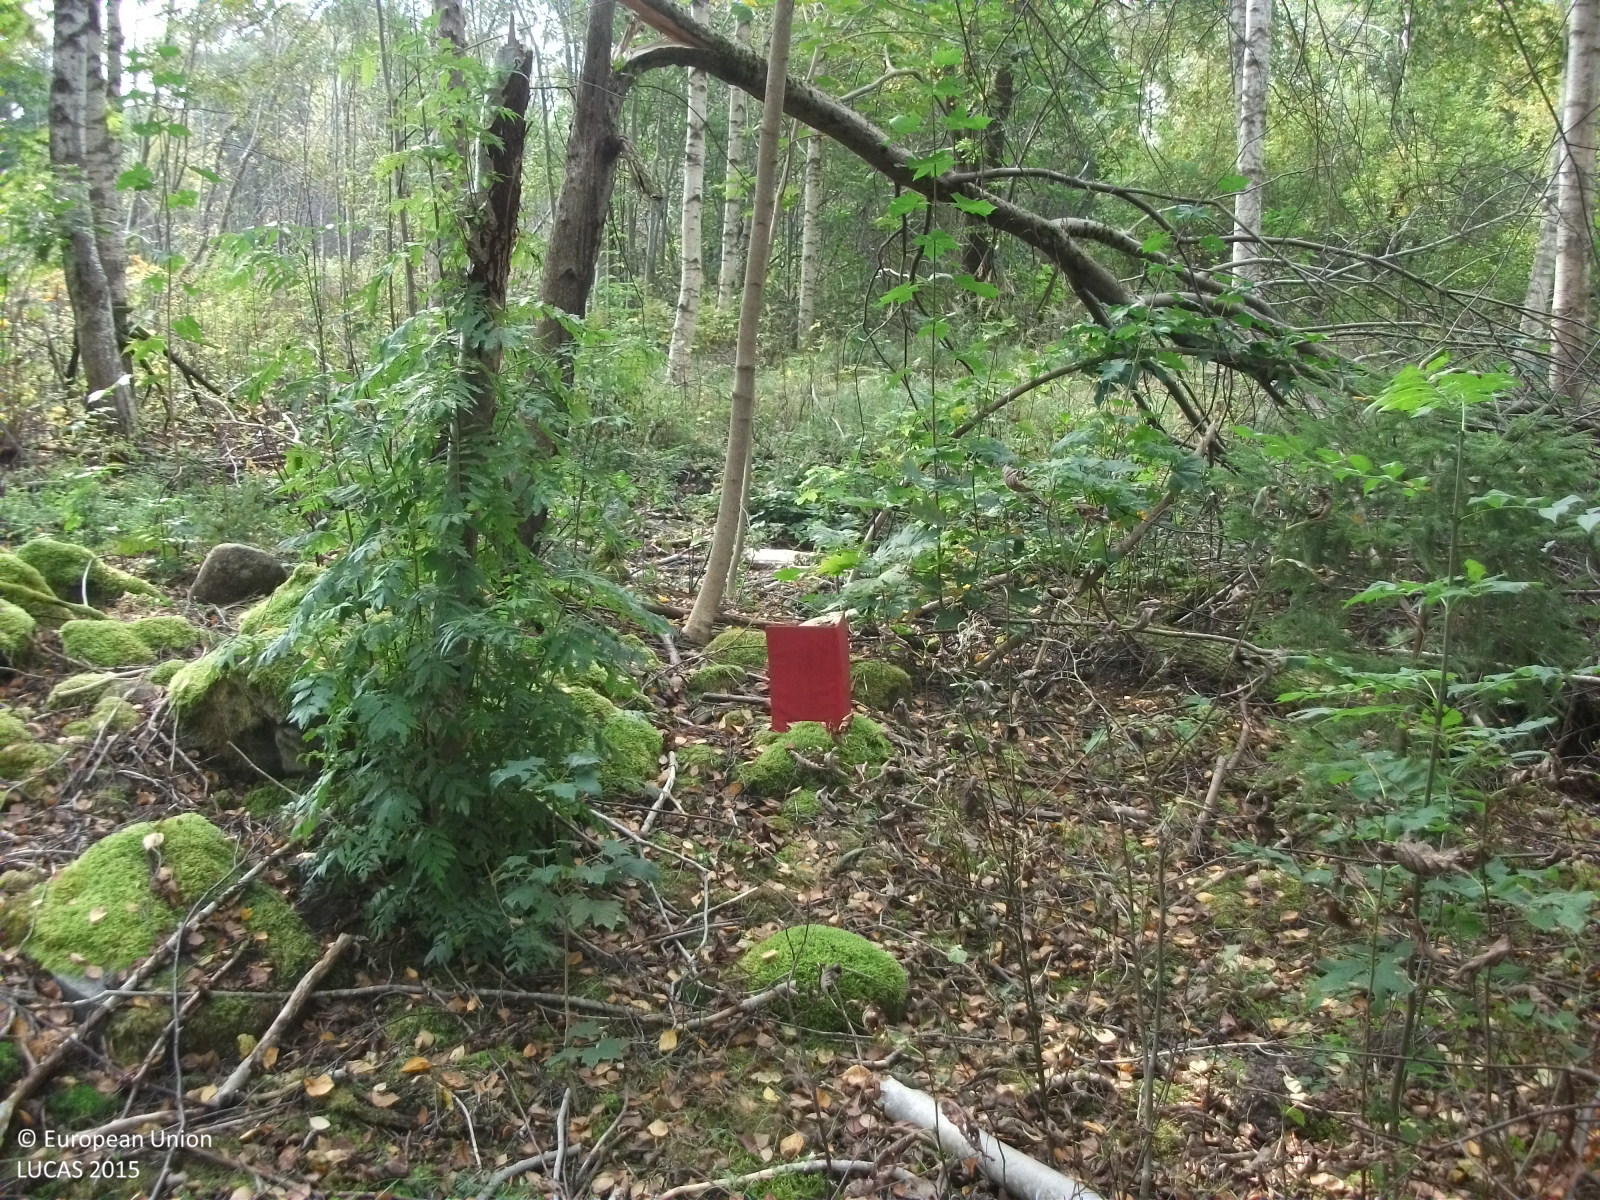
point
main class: Woodland
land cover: Broadleaved woodland
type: non-riverine alder, birch or aspen forest
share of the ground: > 75 %
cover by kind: broadleaved forest trees 80 %, herbaceous plants 10 %, shrubs 5 %
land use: Forestry
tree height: > 5 m
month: September
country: LV
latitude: 57.7965
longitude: 24.4732
